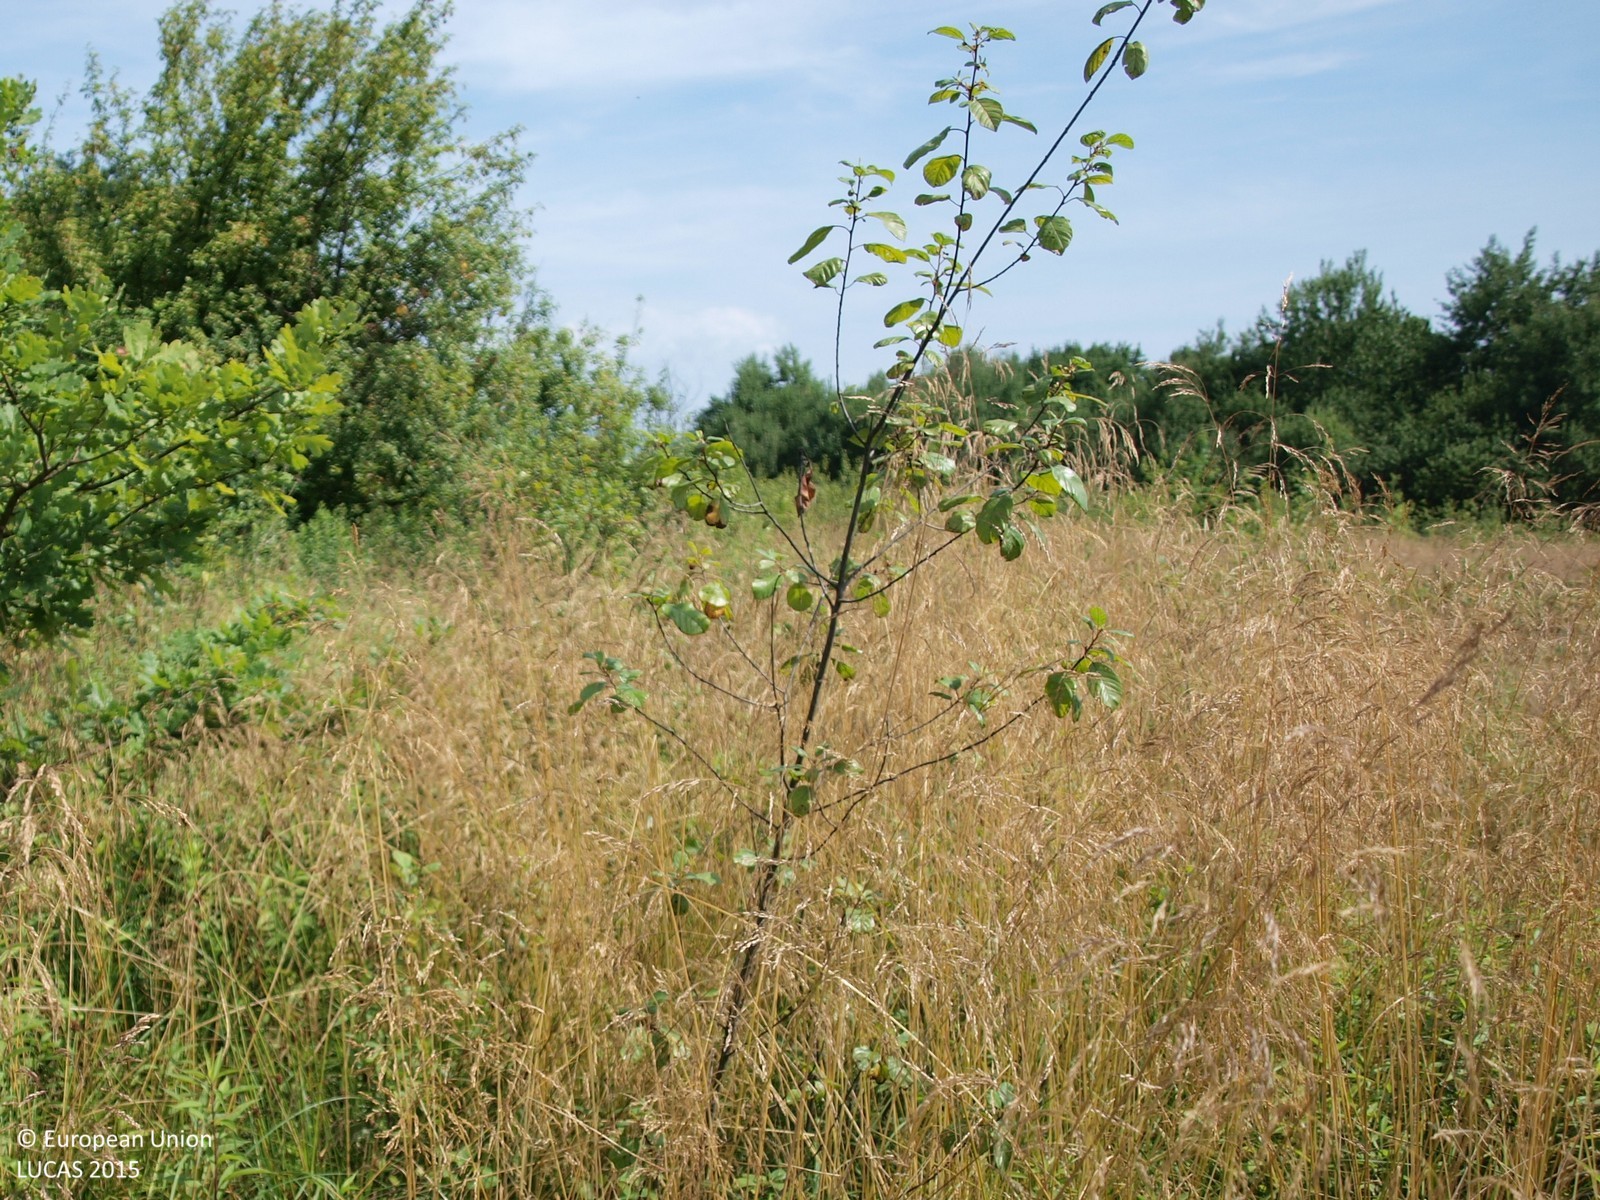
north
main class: Grassland
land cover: Grassland with sparse tree/shrub cover
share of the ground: > 75 %
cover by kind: herbaceous plants 90 %, broadleaved forest trees 5 %, shrubs 5 %
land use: Fallow land
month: July
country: HR
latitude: 45.7399
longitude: 15.8452
